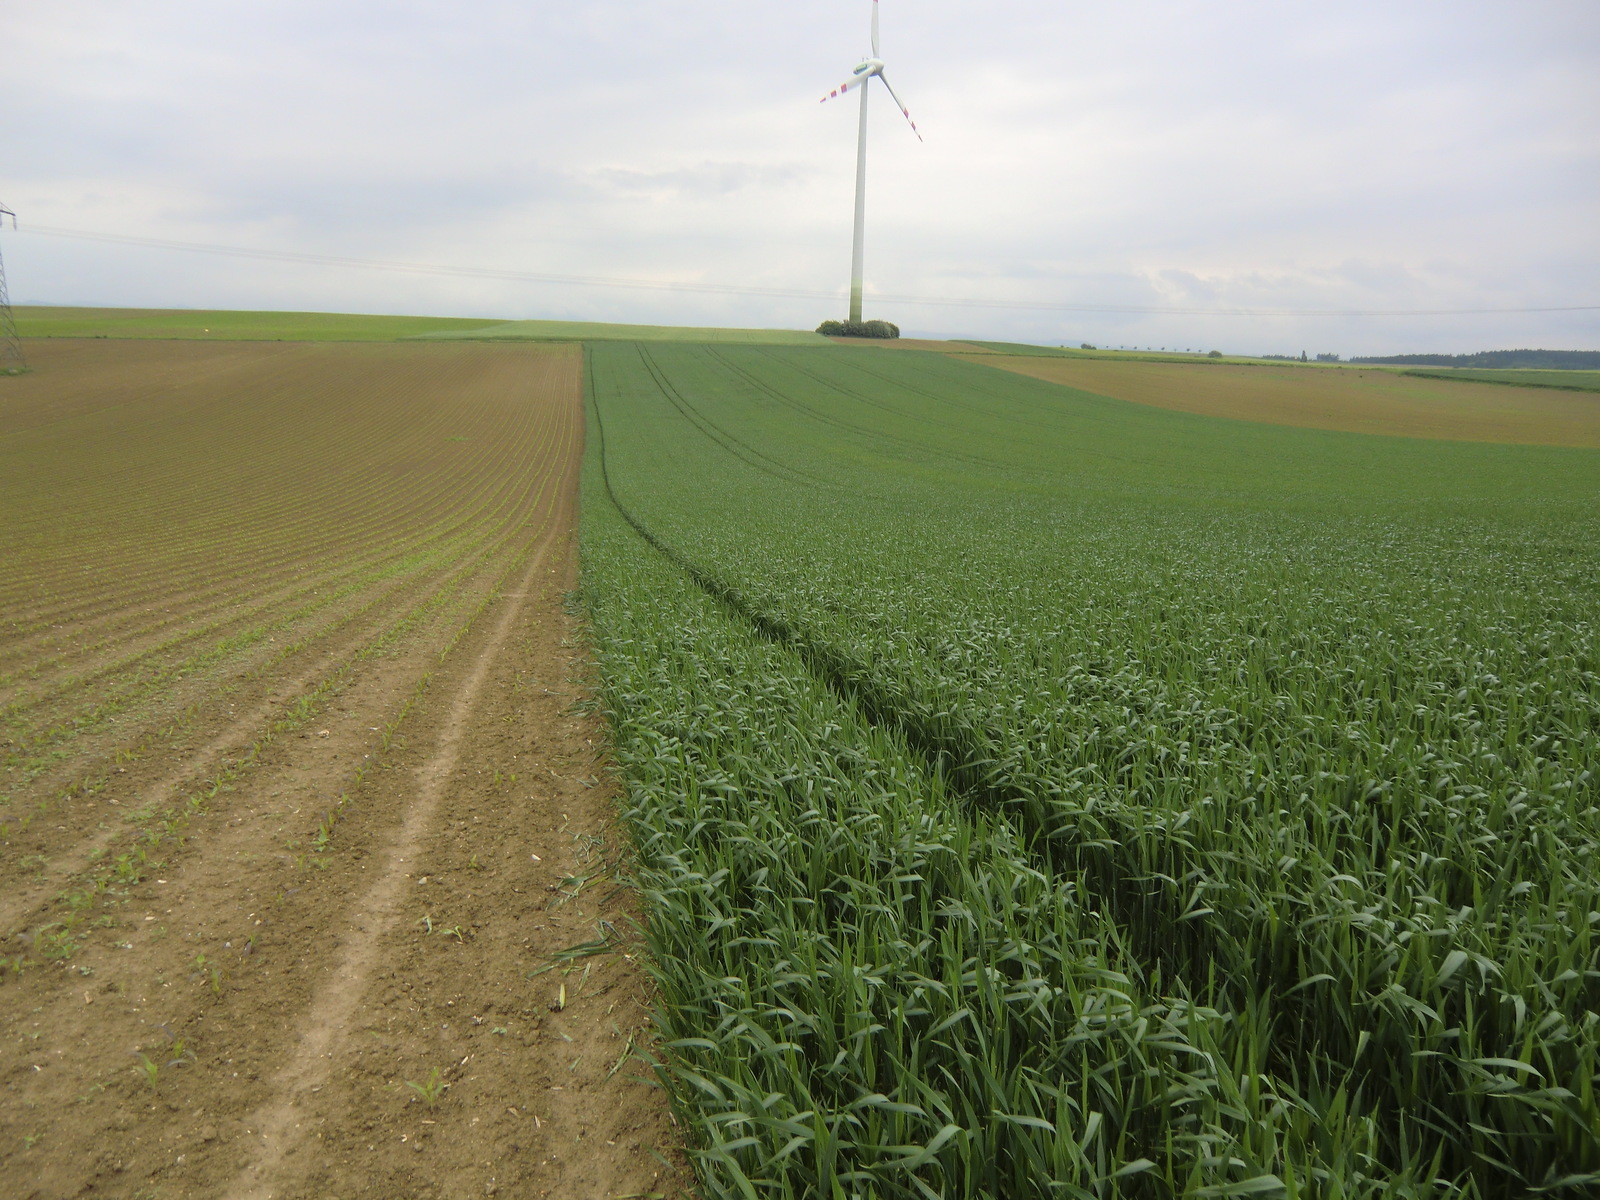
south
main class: Cropland
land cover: Common wheat
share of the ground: > 75 %
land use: Agriculture (excluding fallow land and kitchen gardens)
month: May
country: AT
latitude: 48.1790
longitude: 15.4490
